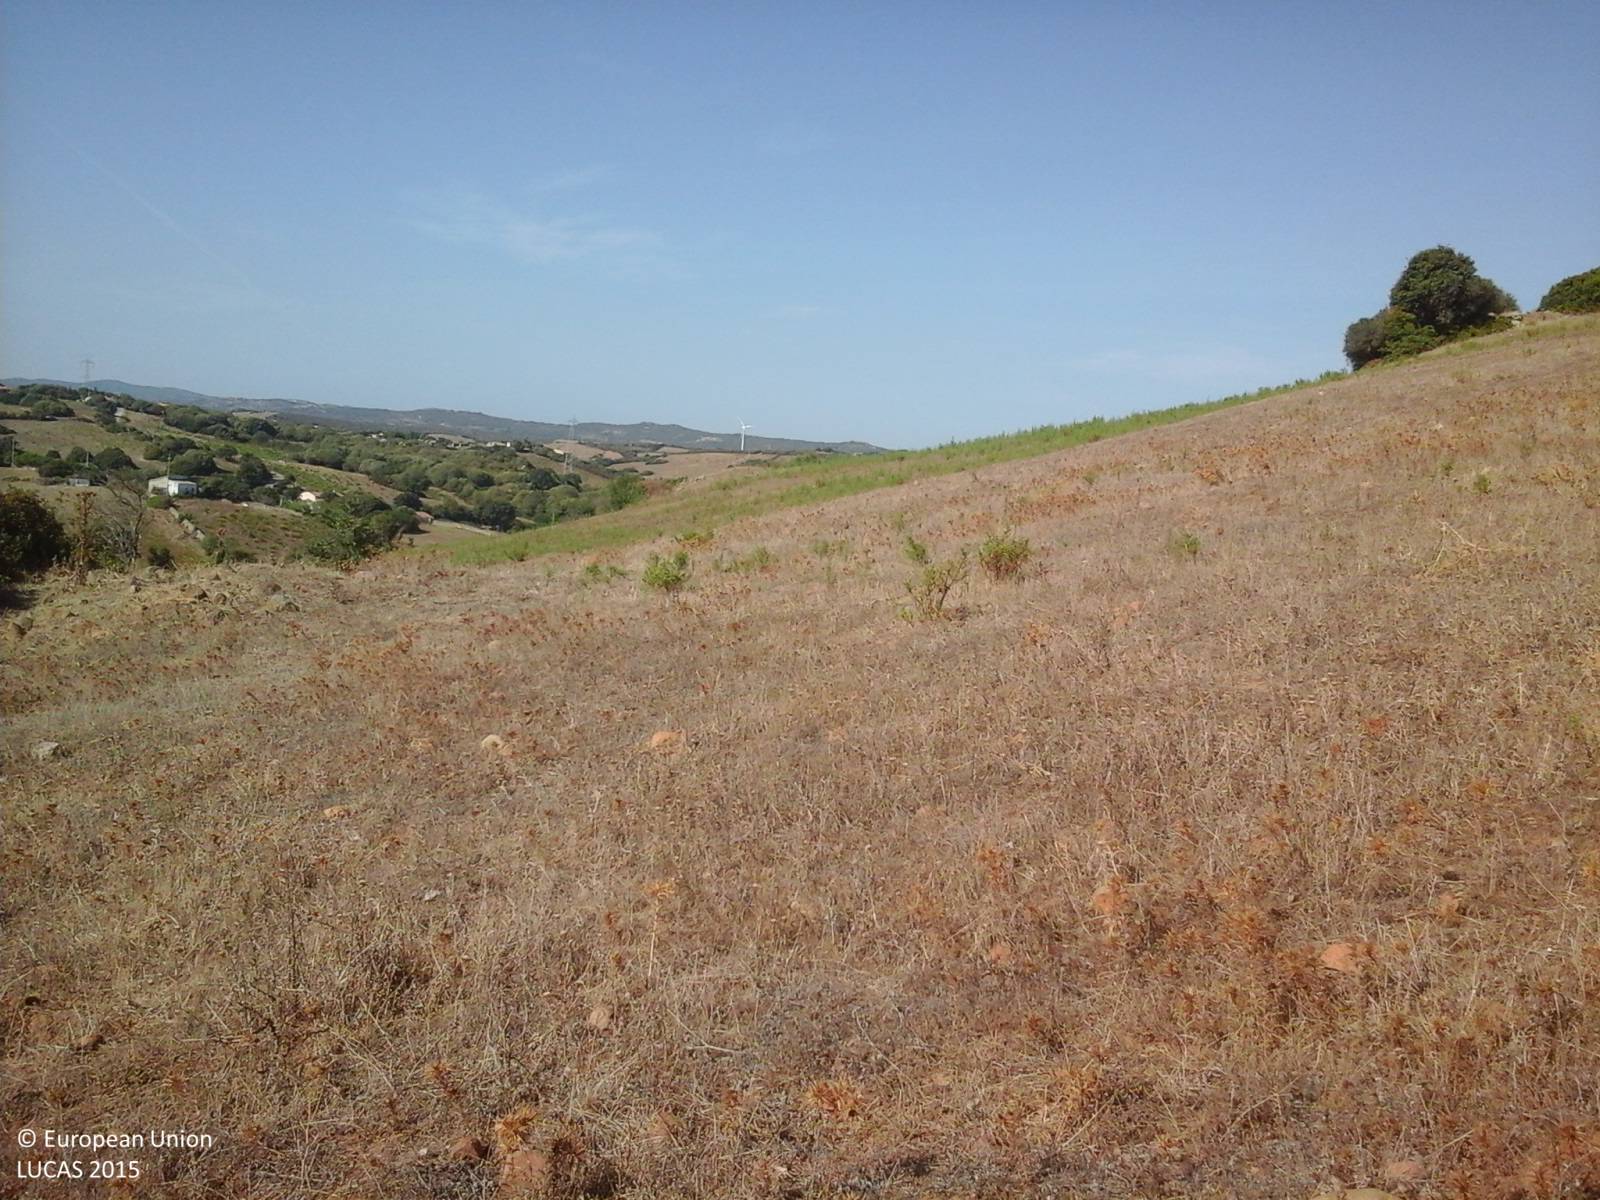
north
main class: Grassland
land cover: Grassland without tree/shrub cover
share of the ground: > 75 %
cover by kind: herbaceous plants 95 %, shrubs 5 %
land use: Agriculture (excluding fallow land and kitchen gardens)
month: September
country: IT
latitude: 41.1148
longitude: 9.2294
